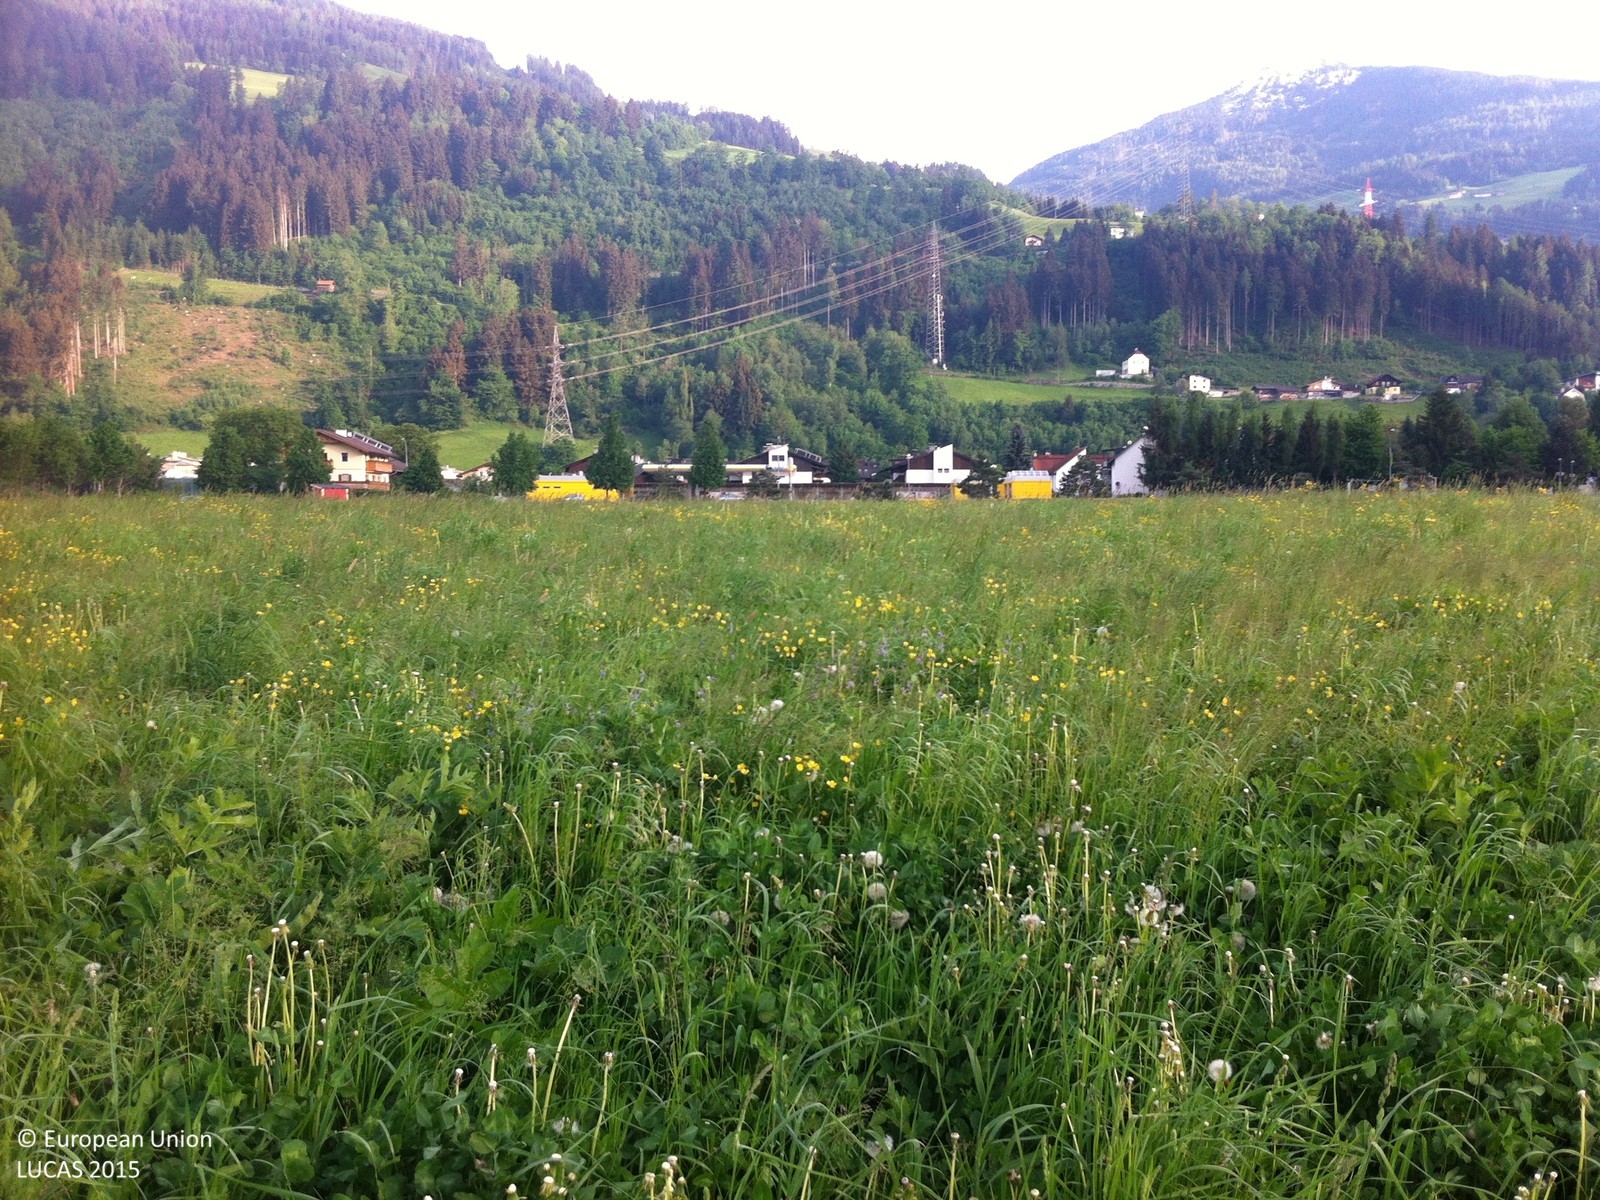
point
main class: Grassland
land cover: Grassland without tree/shrub cover
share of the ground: > 75 %
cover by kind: herbaceous plants 100 %
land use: Agriculture (excluding fallow land and kitchen gardens)
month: May
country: AT
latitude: 47.2938
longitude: 11.5987
